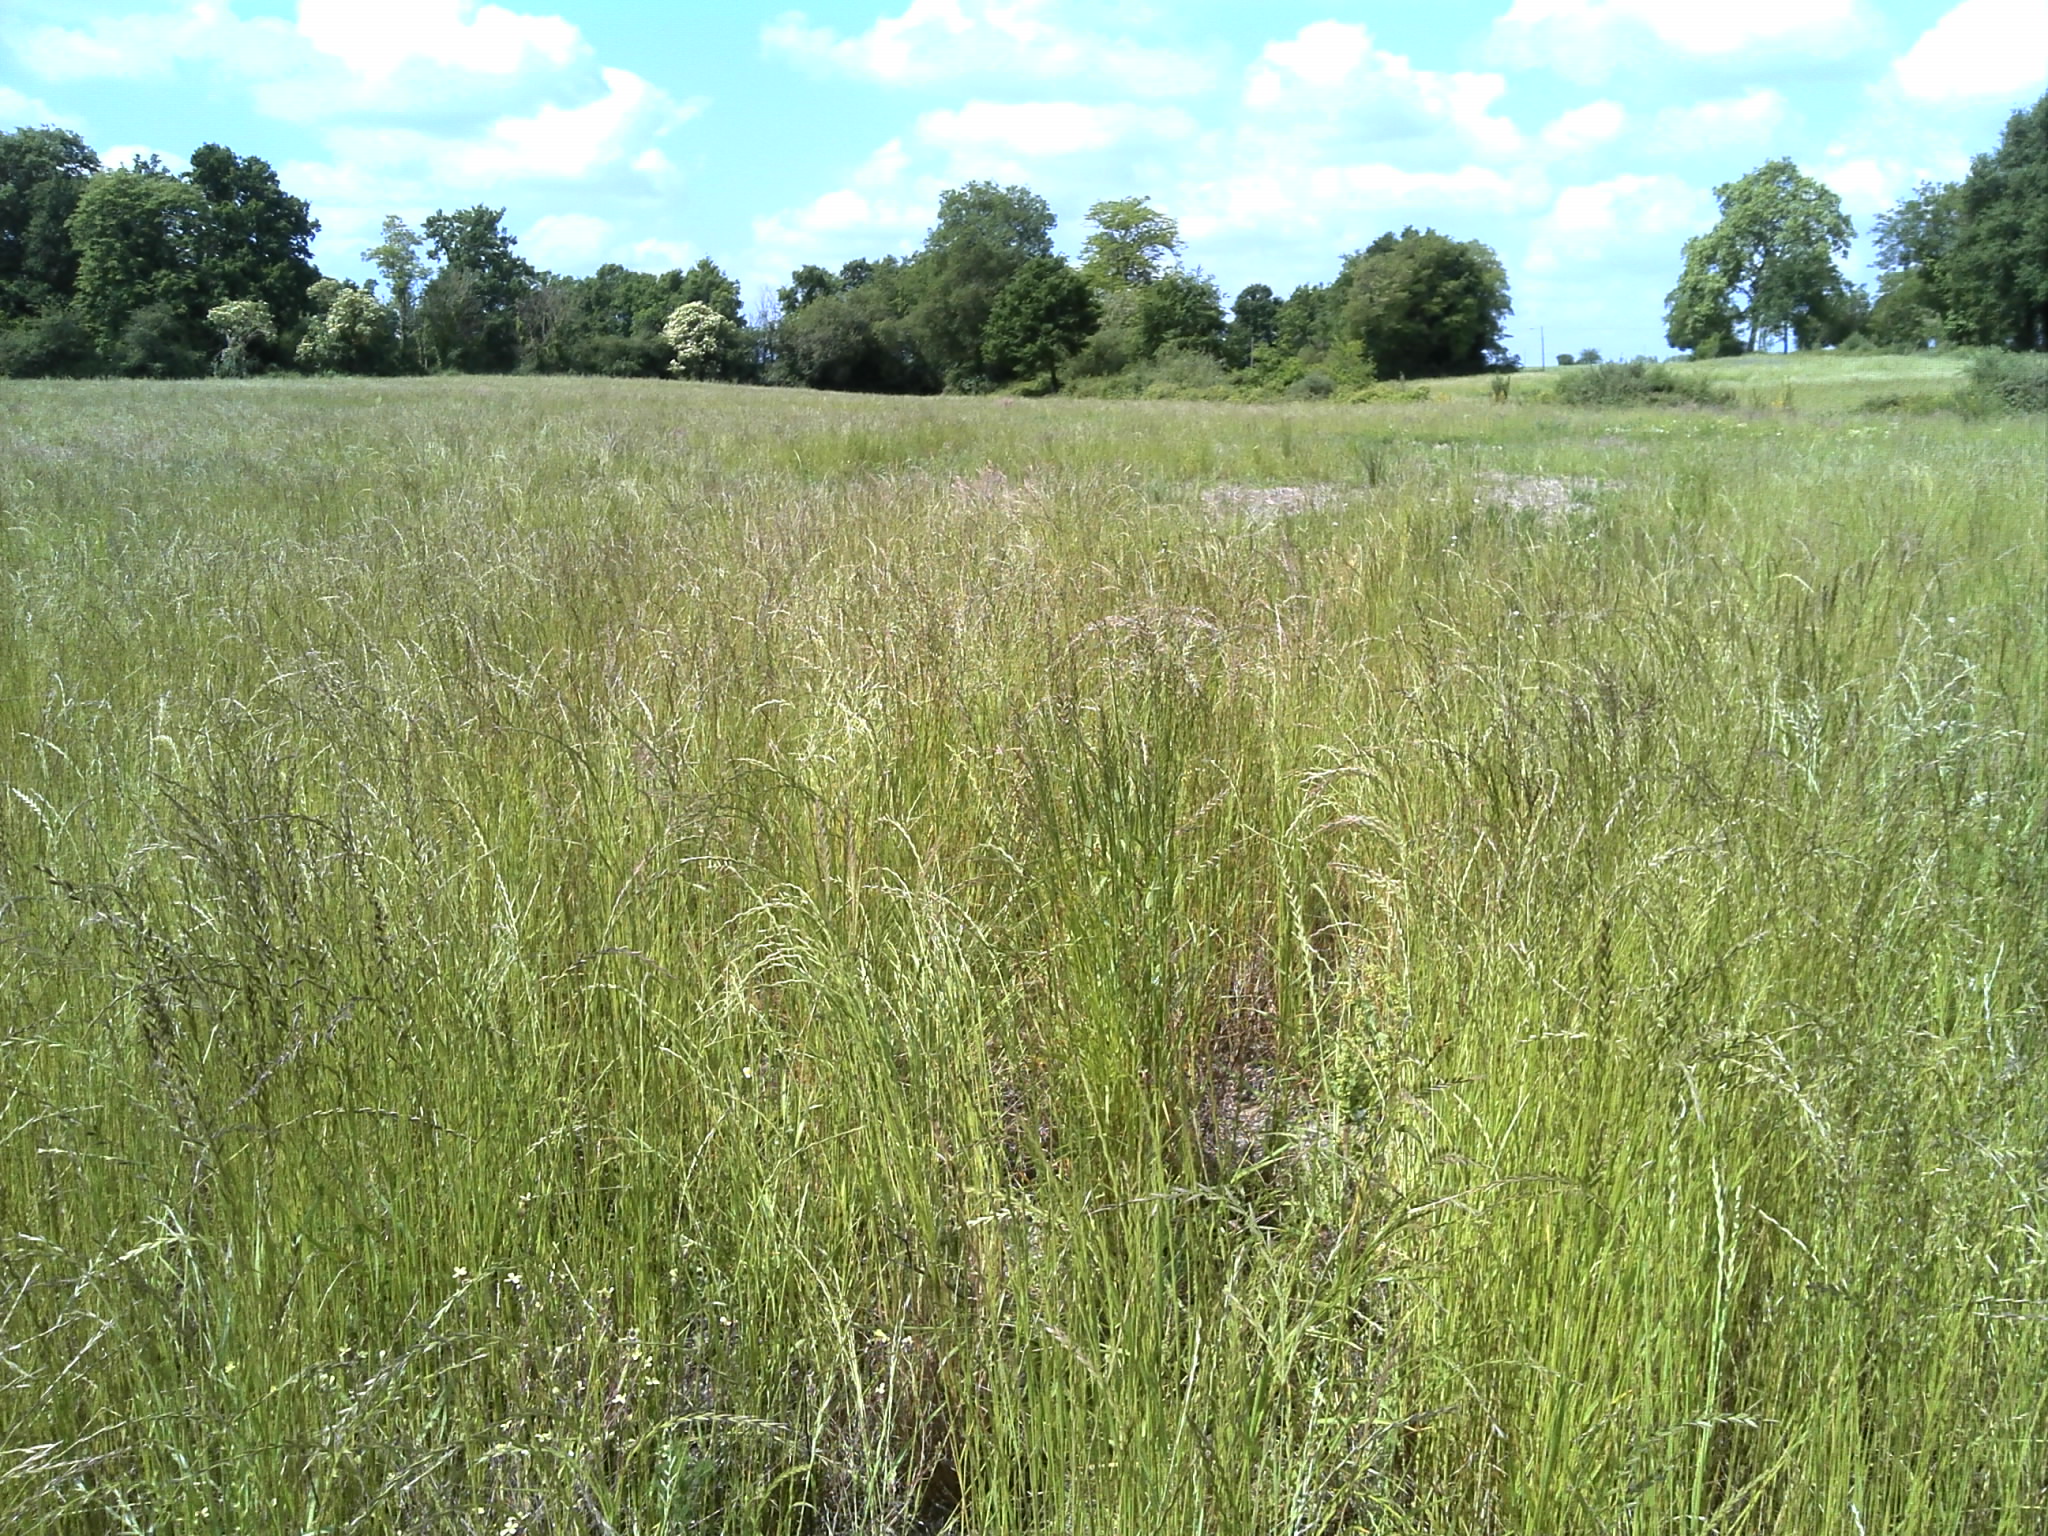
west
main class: Cropland
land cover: Temporary grasslands
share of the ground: > 75 %
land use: Agriculture (excluding fallow land and kitchen gardens)
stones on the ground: < 10 %
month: May
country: FR
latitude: 46.6709
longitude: 1.5848
